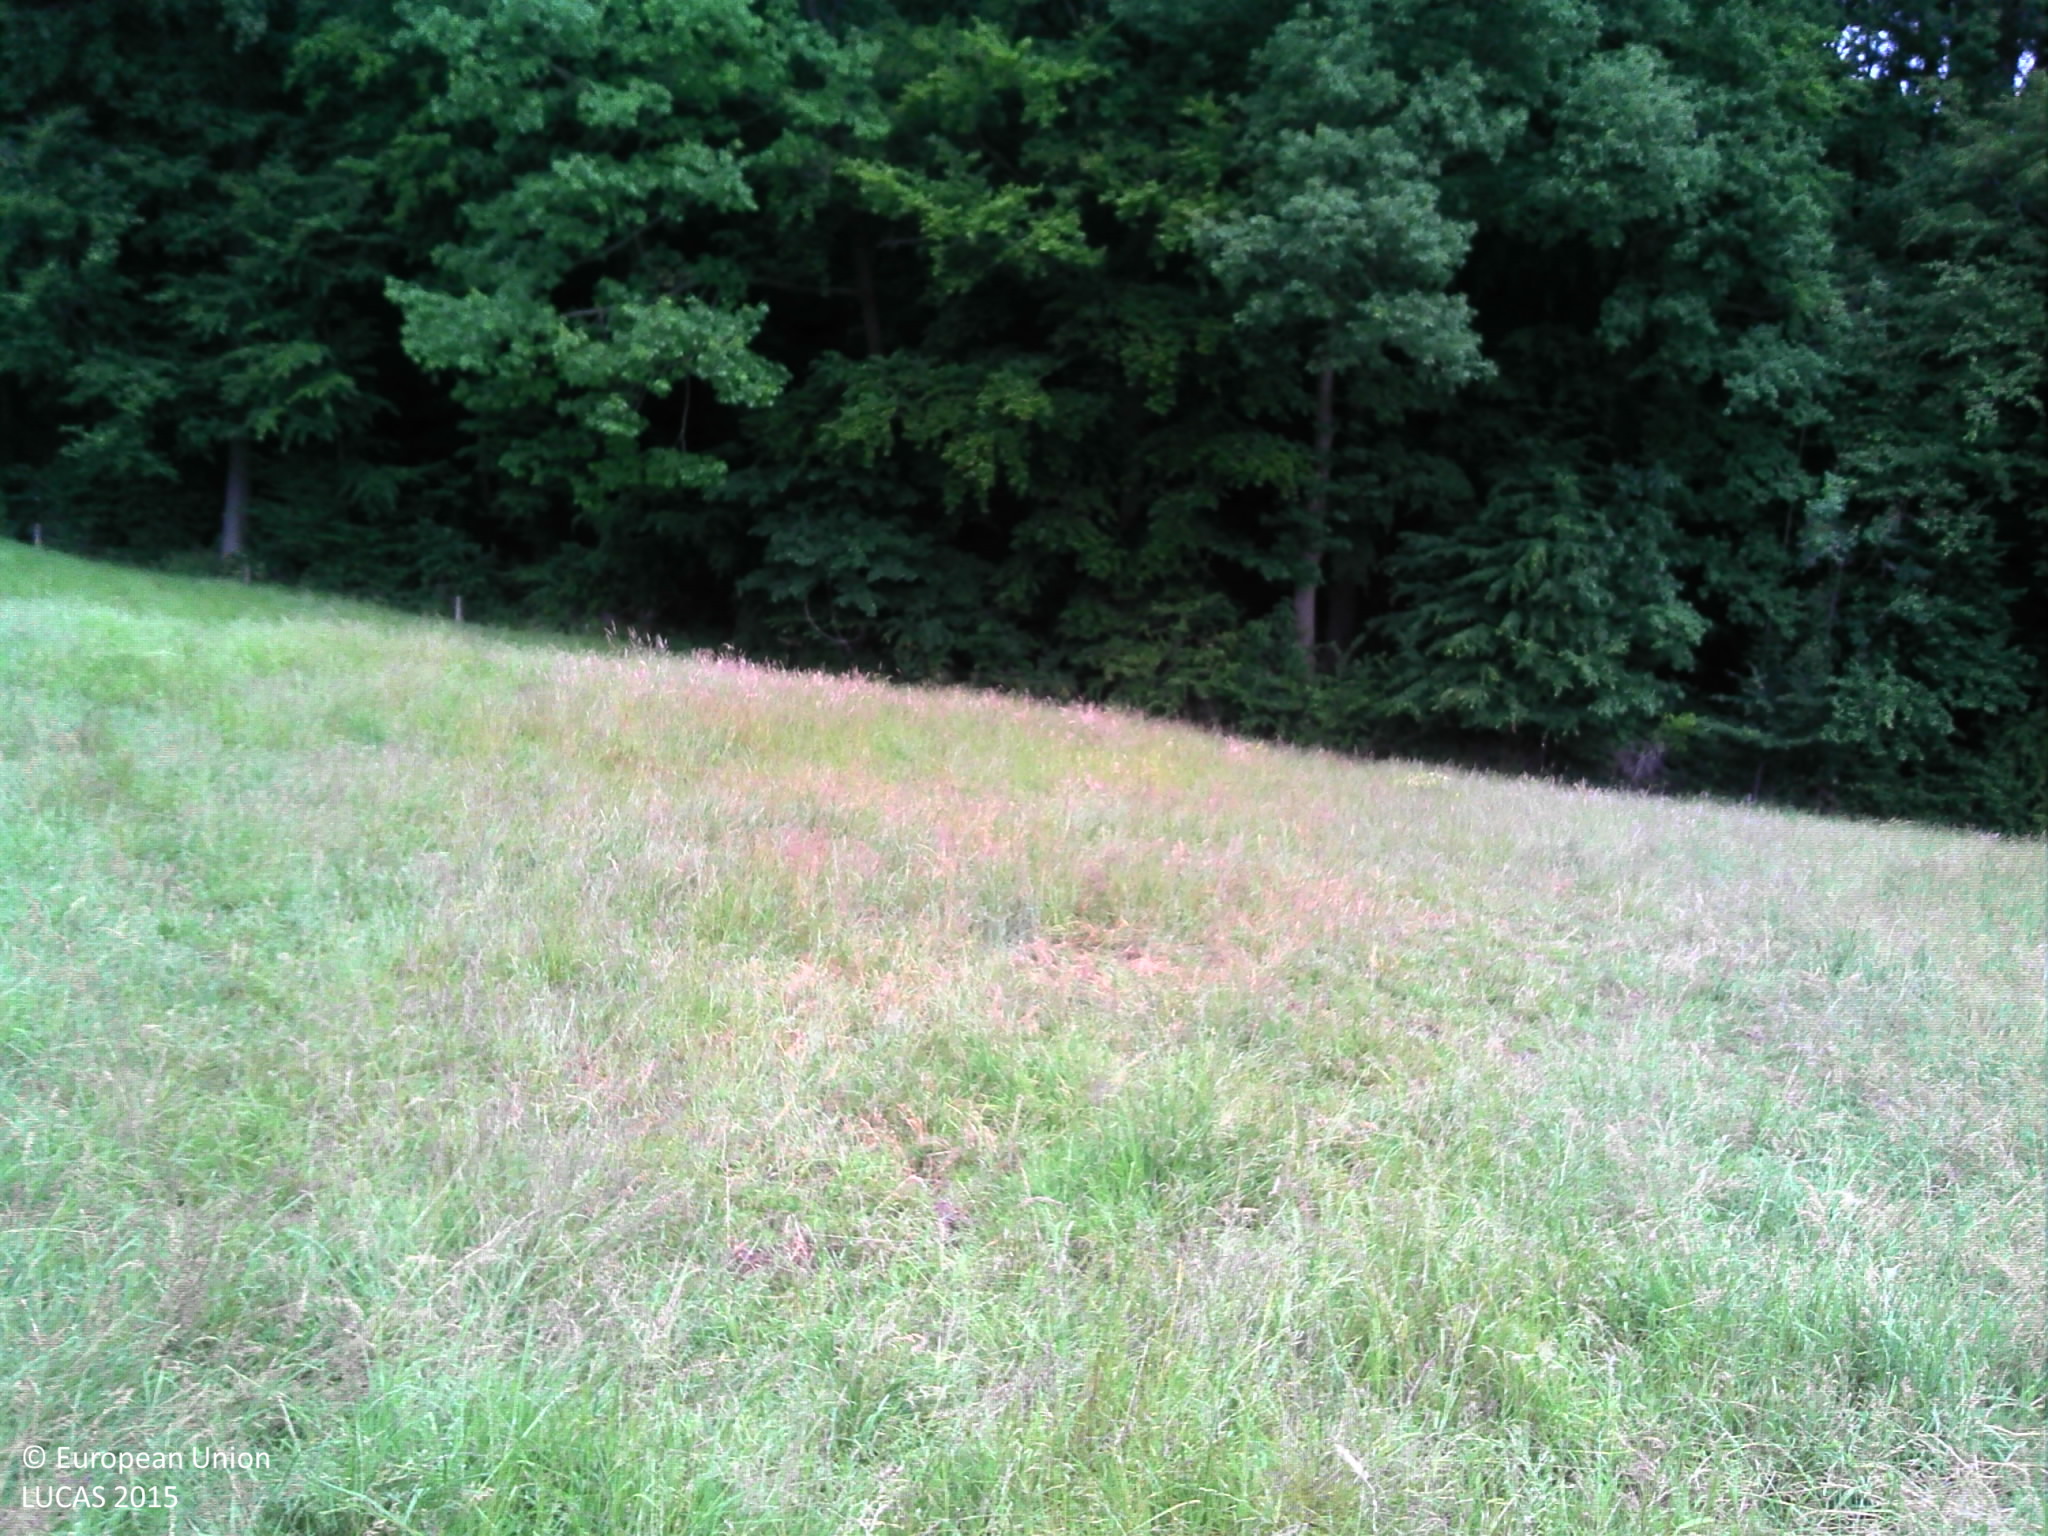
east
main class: Grassland
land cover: Grassland without tree/shrub cover
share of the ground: > 75 %
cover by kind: herbaceous plants 100 %
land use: Agriculture (excluding fallow land and kitchen gardens)
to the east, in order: Grassland without tree/shrub cover; Fences; Ditches and canals; Broadleaved woodland; Ditches and canals; Broadleaved woodland; Tracks; Broadleaved woodland; Tracks; Broadleaved woodland; Inland fresh running water; Broadleaved woodland; Tracks; Broadleaved woodland
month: June
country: BE
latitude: 50.7651
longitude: 3.6553
